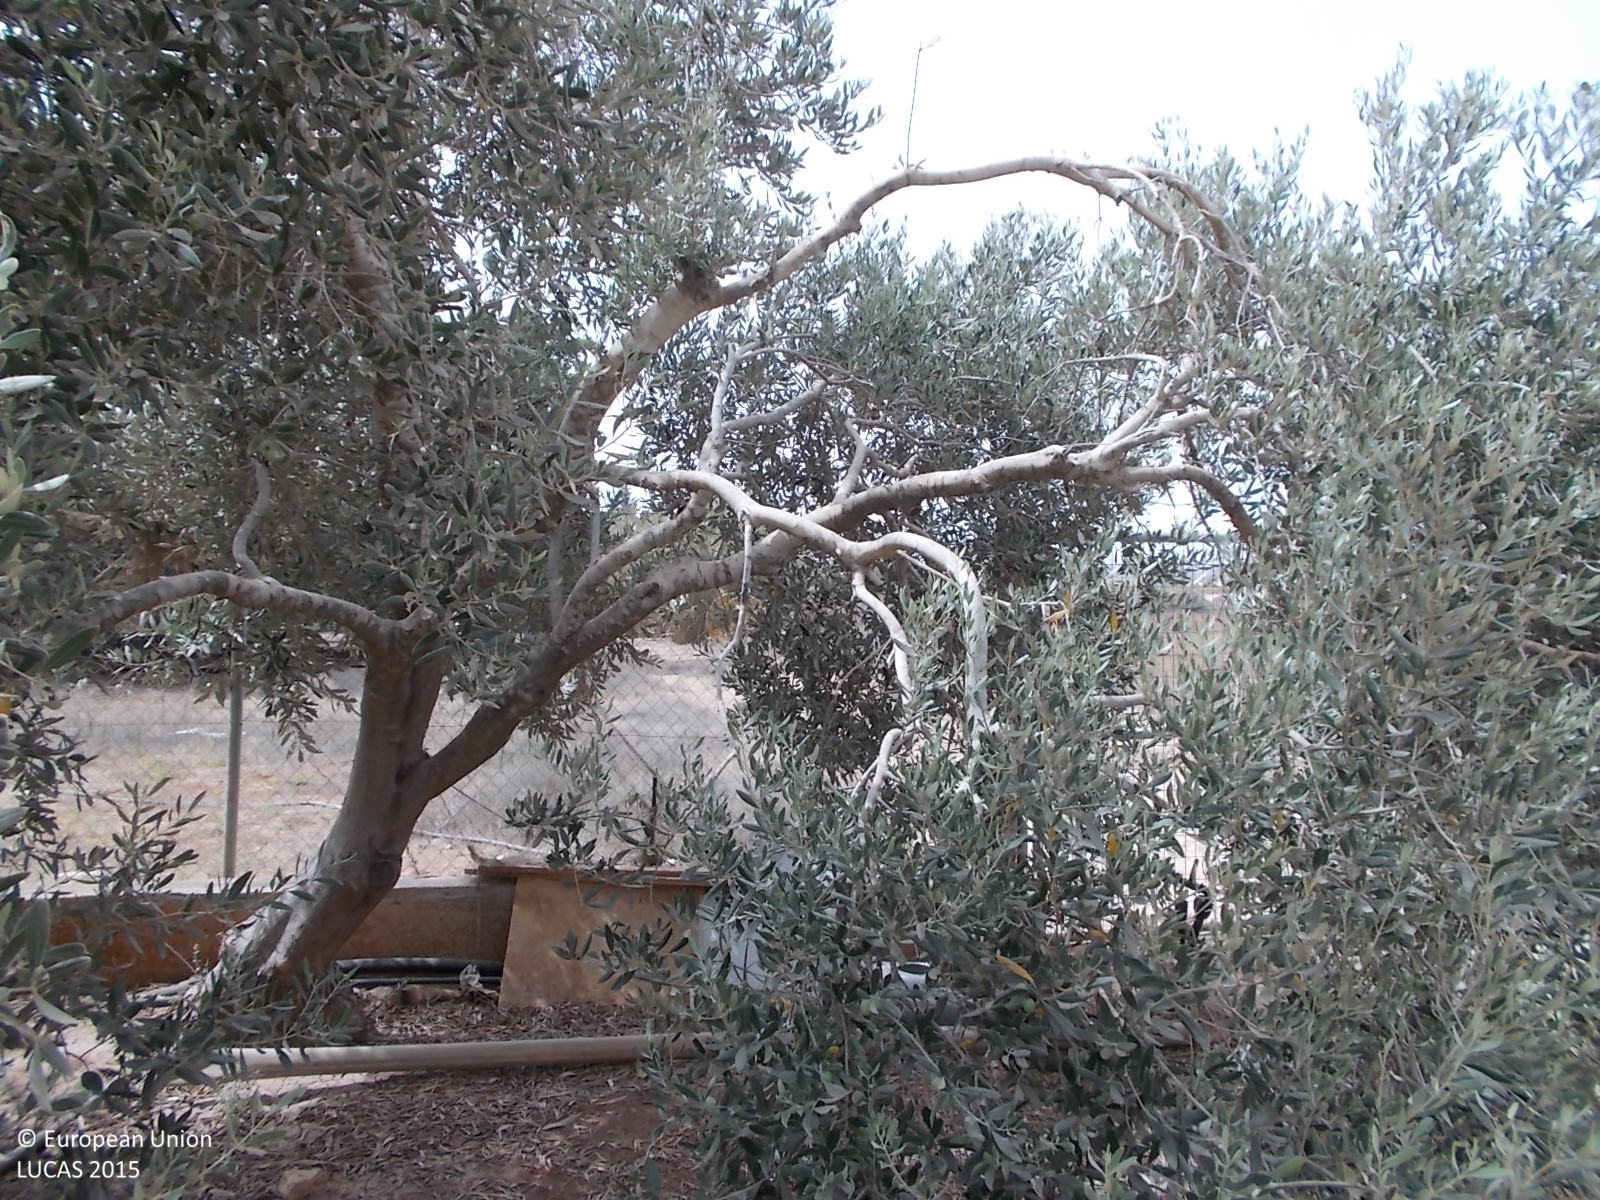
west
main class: Cropland
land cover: Olive groves
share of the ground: > 75 %
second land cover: Other bare soil
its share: > 75 %
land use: Agriculture (excluding fallow land and kitchen gardens)
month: March
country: CY
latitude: 34.9845
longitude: 34.0658
